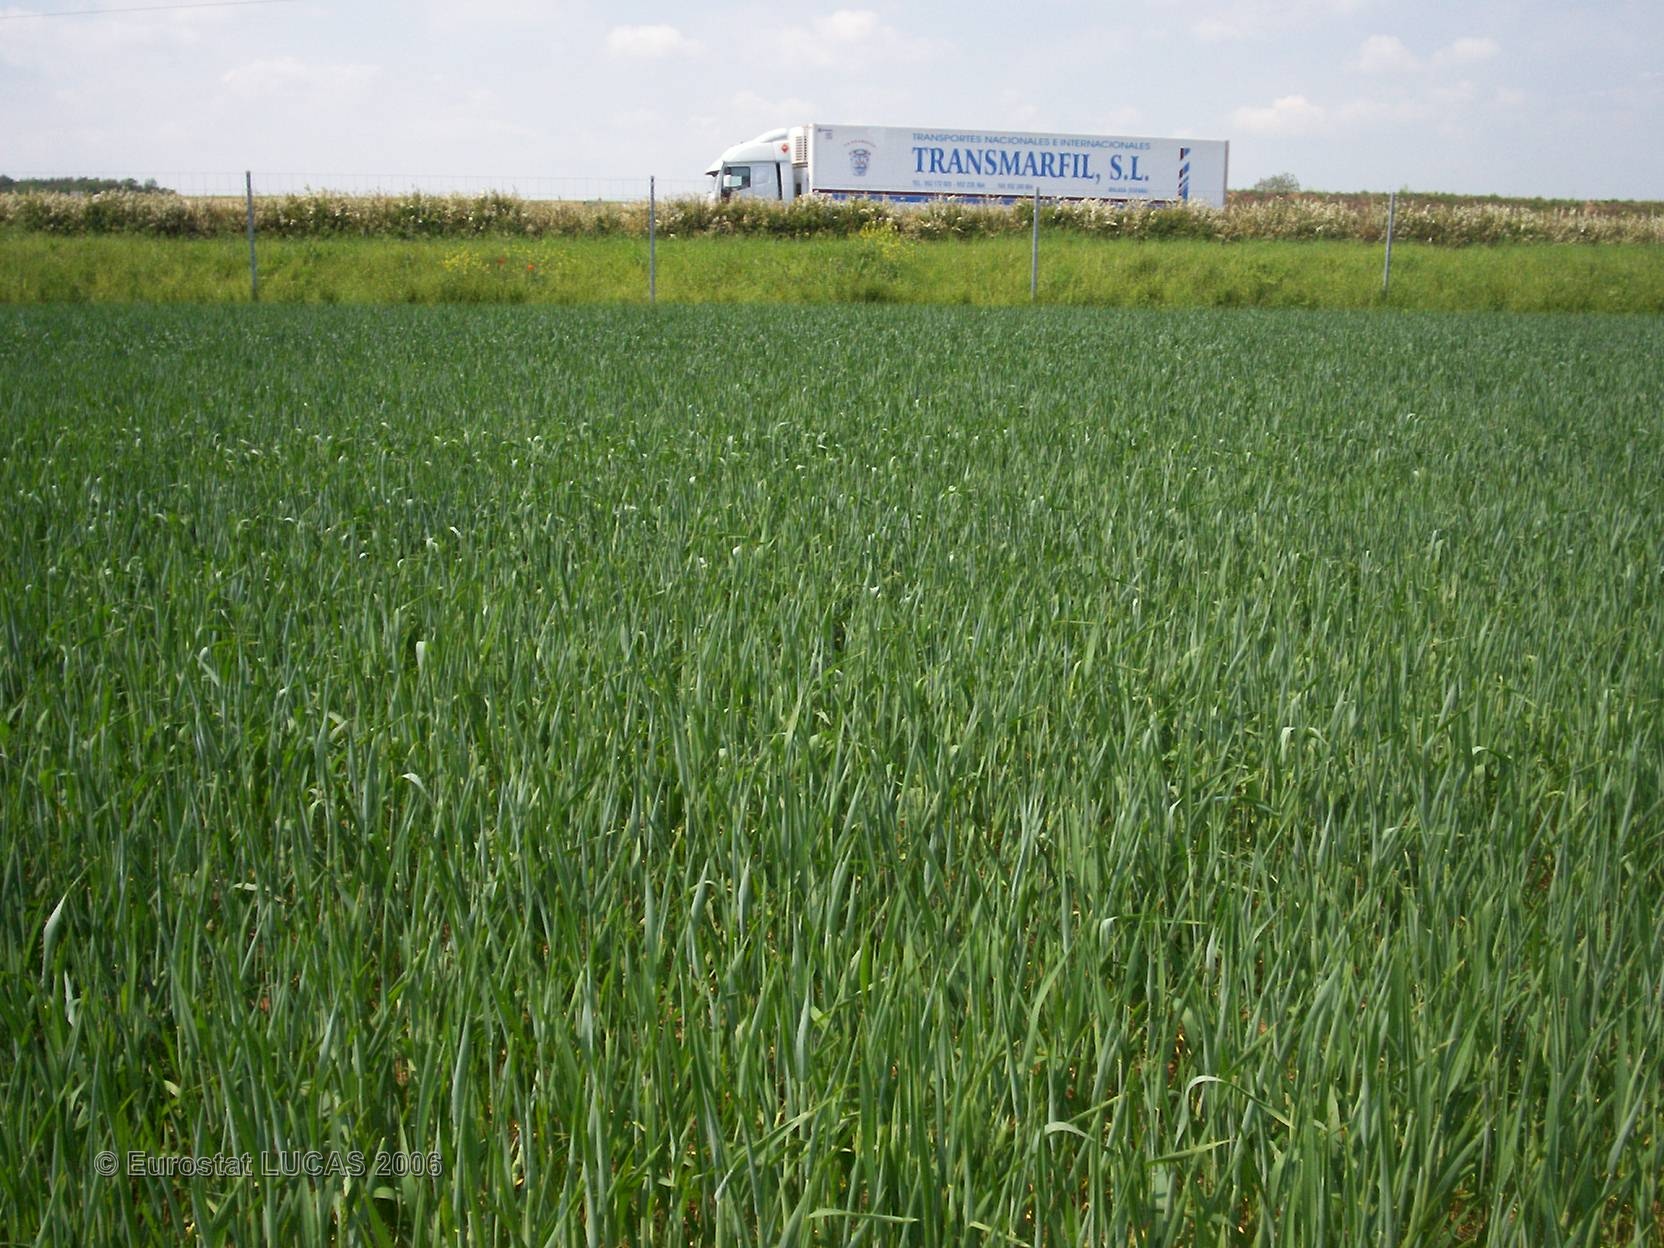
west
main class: Cropland
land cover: Common wheat
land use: Agriculture (excluding fallow land and kitchen gardens)
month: May
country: FR
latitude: 46.6953
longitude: 0.3690
